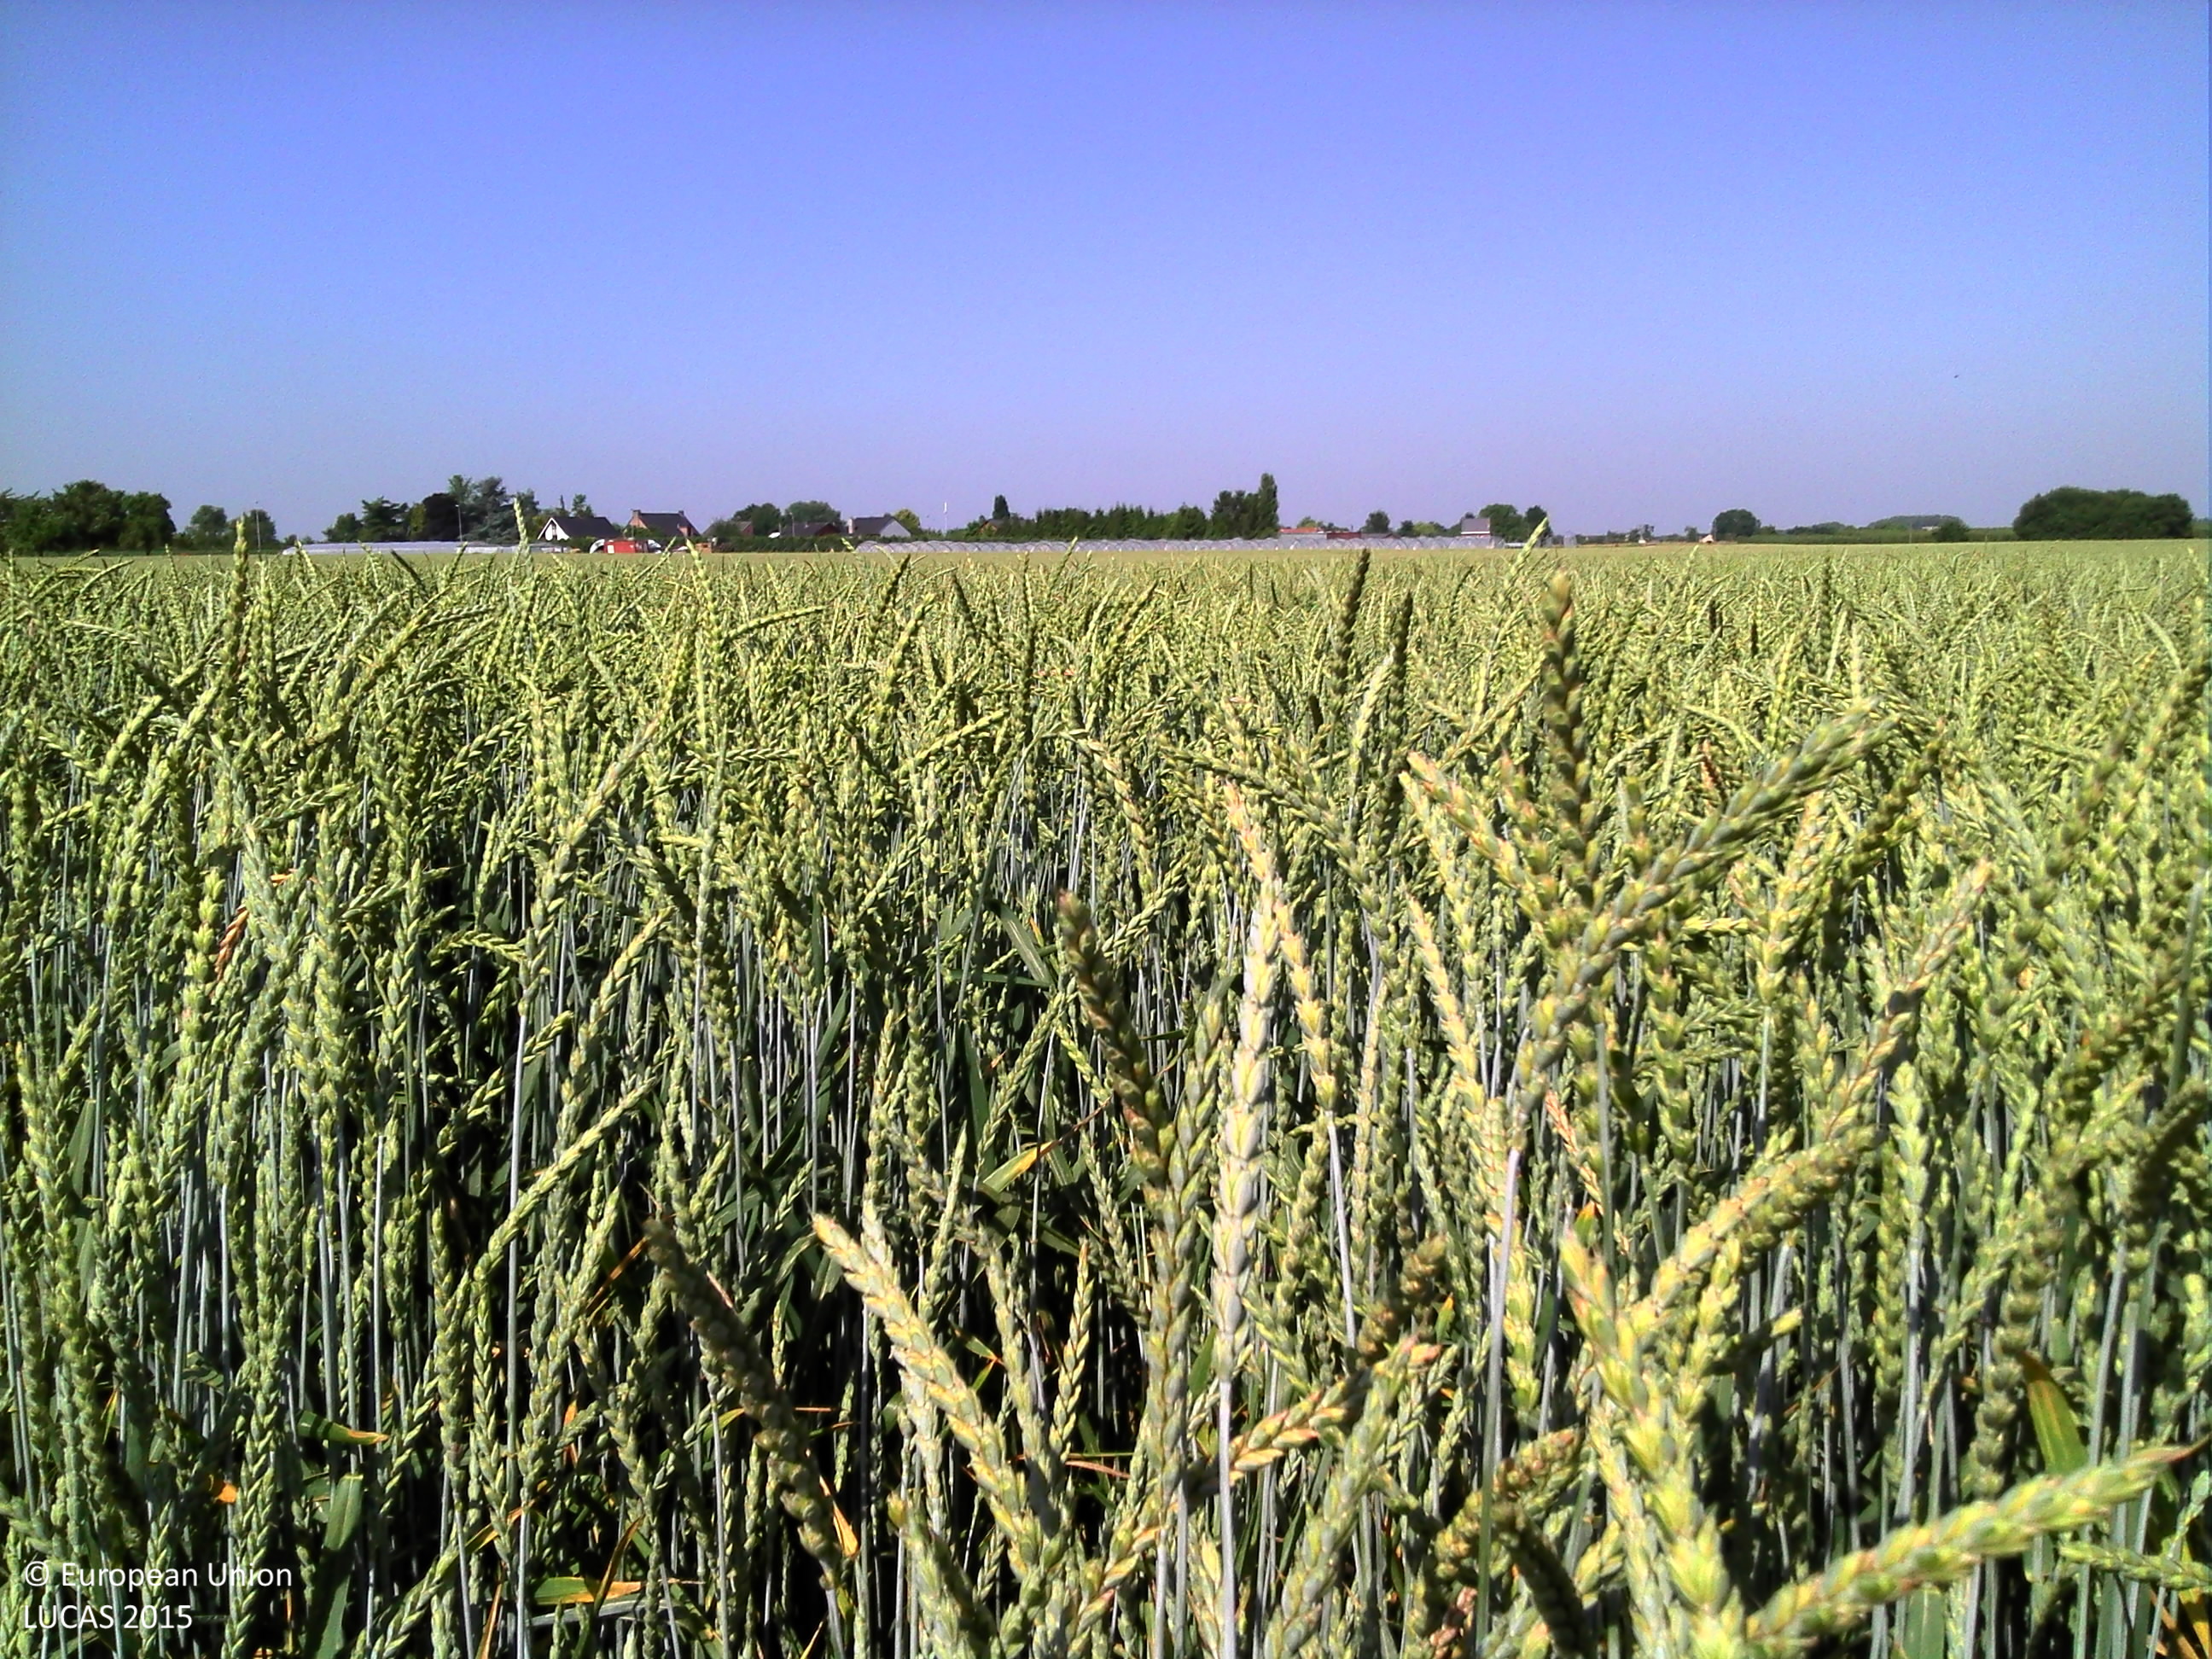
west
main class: Cropland
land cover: Common wheat
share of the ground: > 75 %
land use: Agriculture (excluding fallow land and kitchen gardens)
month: June
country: BE
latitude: 50.8199
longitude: 5.1571
